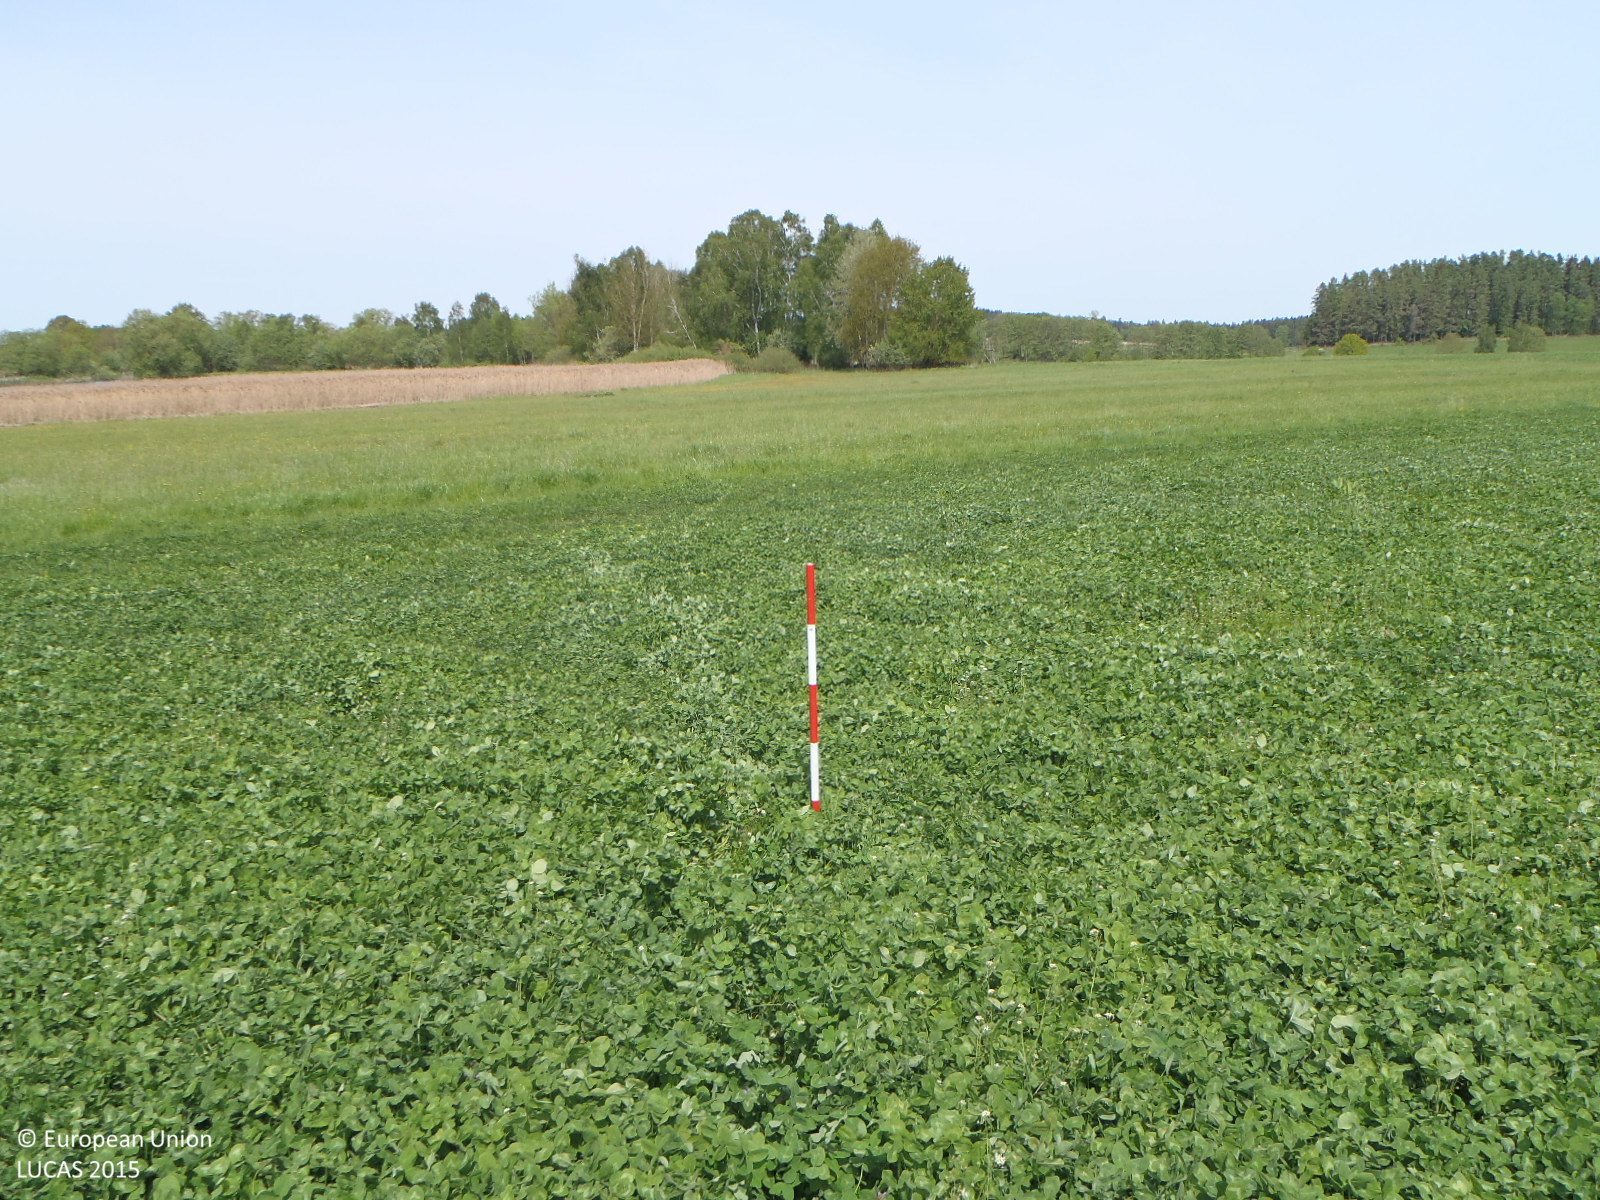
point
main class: Cropland
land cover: Clovers
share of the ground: > 75 %
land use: Agriculture (excluding fallow land and kitchen gardens)
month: May
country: CZ
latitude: 49.1601
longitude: 14.8976
